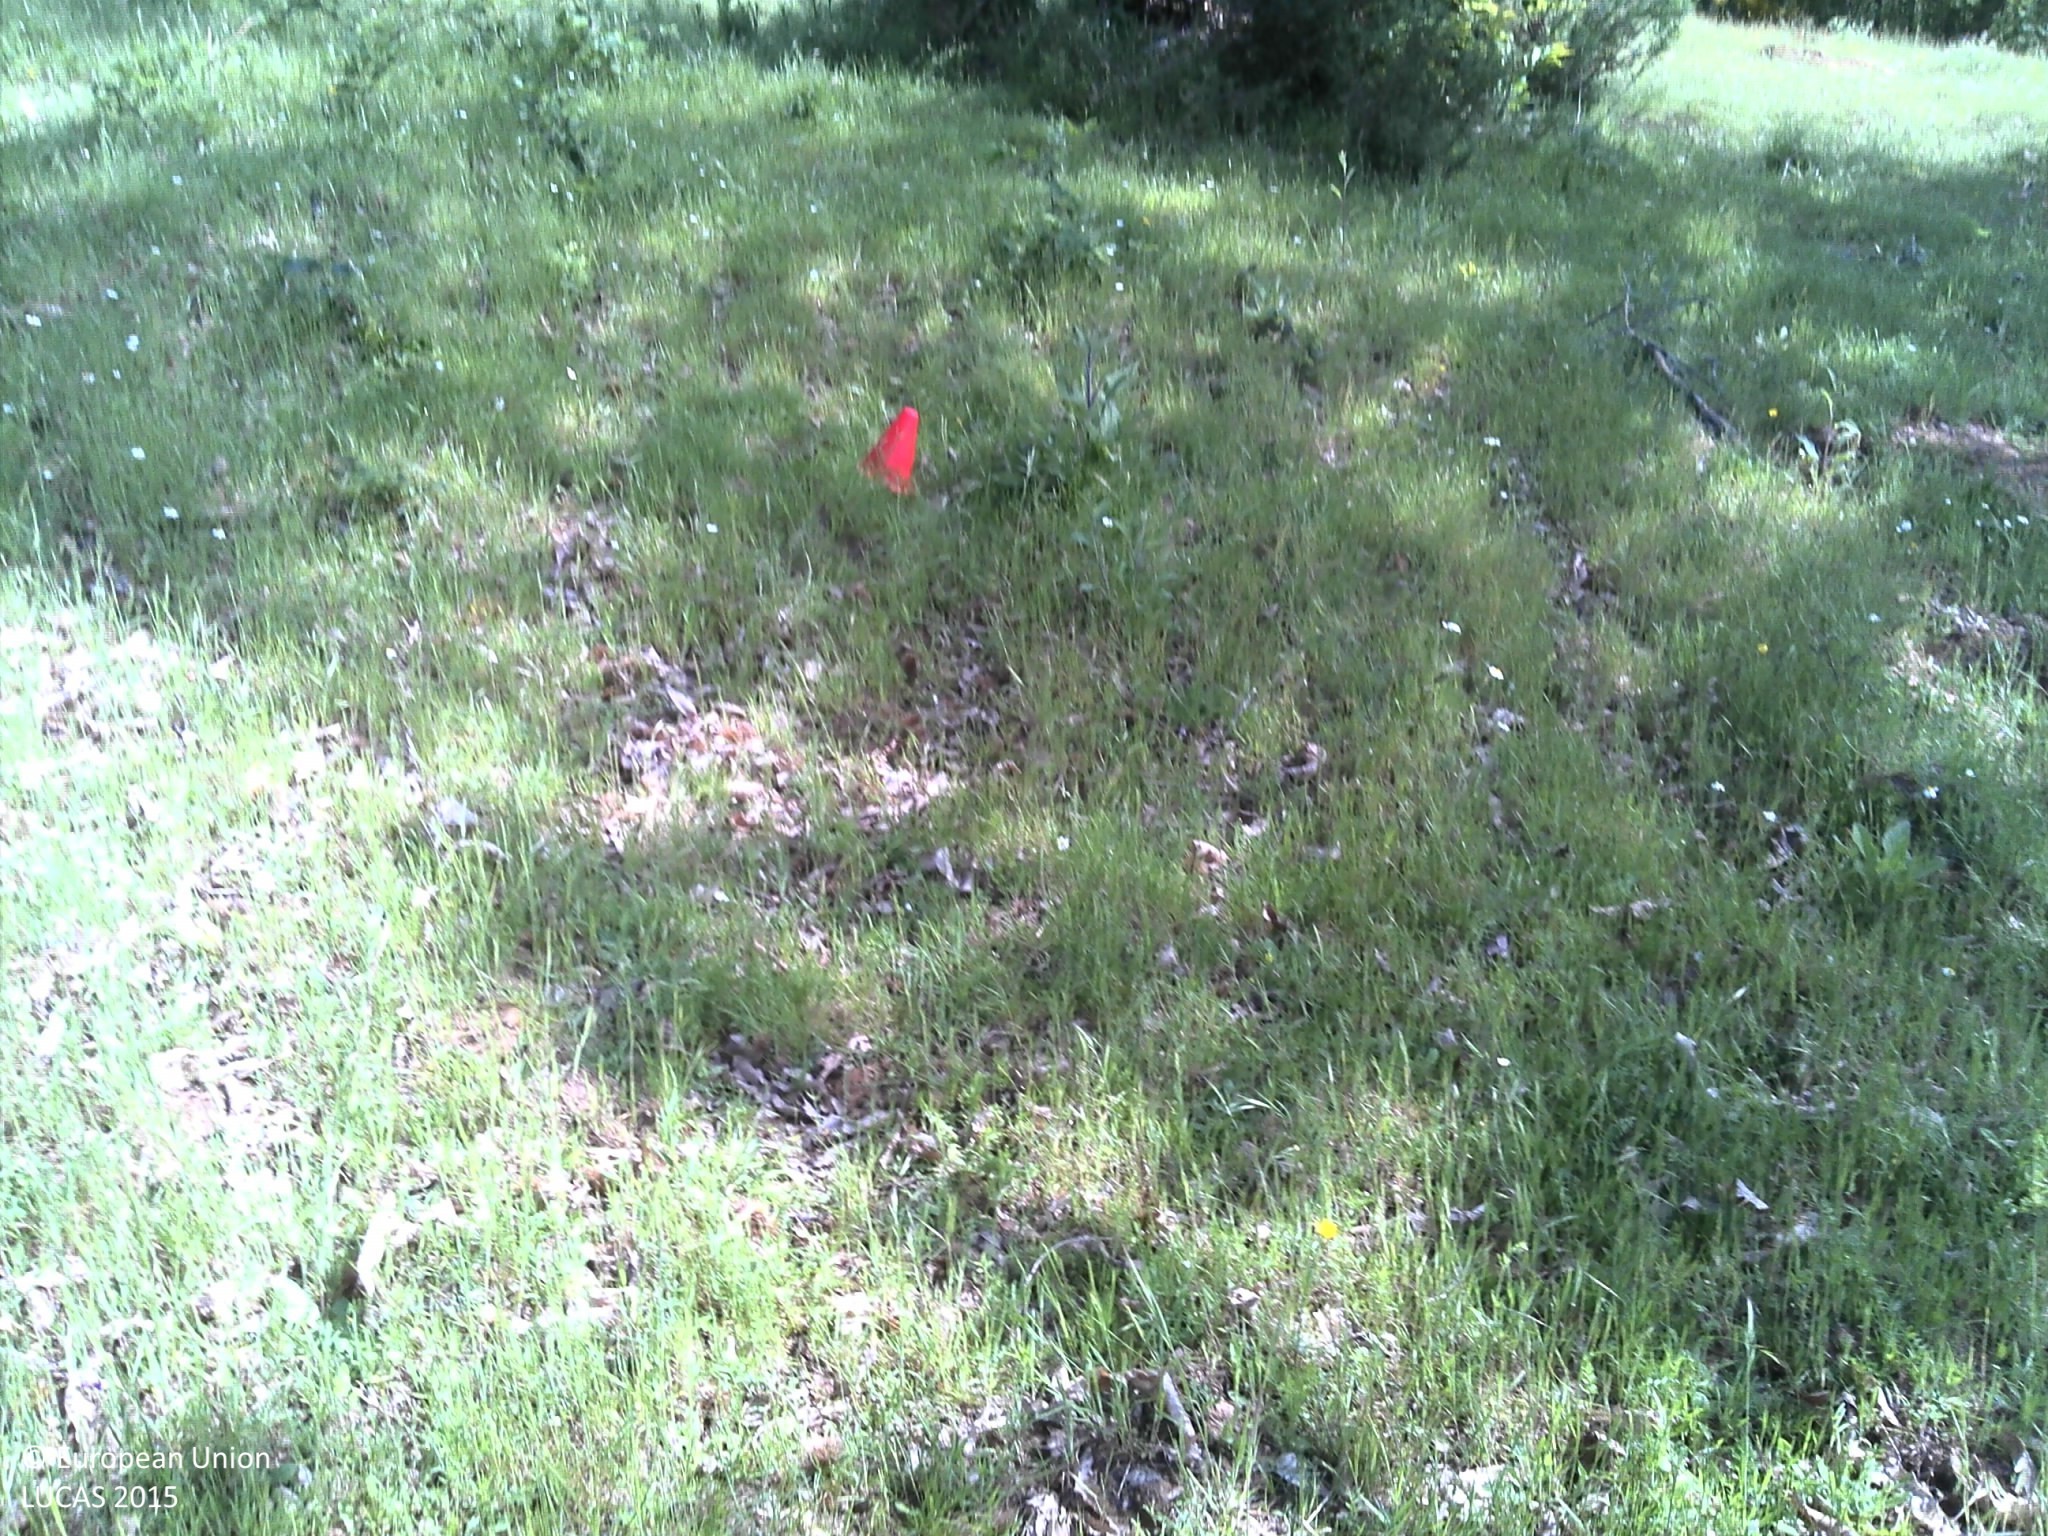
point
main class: Cropland
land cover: Nuts trees
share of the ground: 25 - 50 %
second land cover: Grassland without tree/shrub cover
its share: 25 - 50 %
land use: Agriculture (excluding fallow land and kitchen gardens)
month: May
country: PT
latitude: 41.8460
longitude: -7.0176
